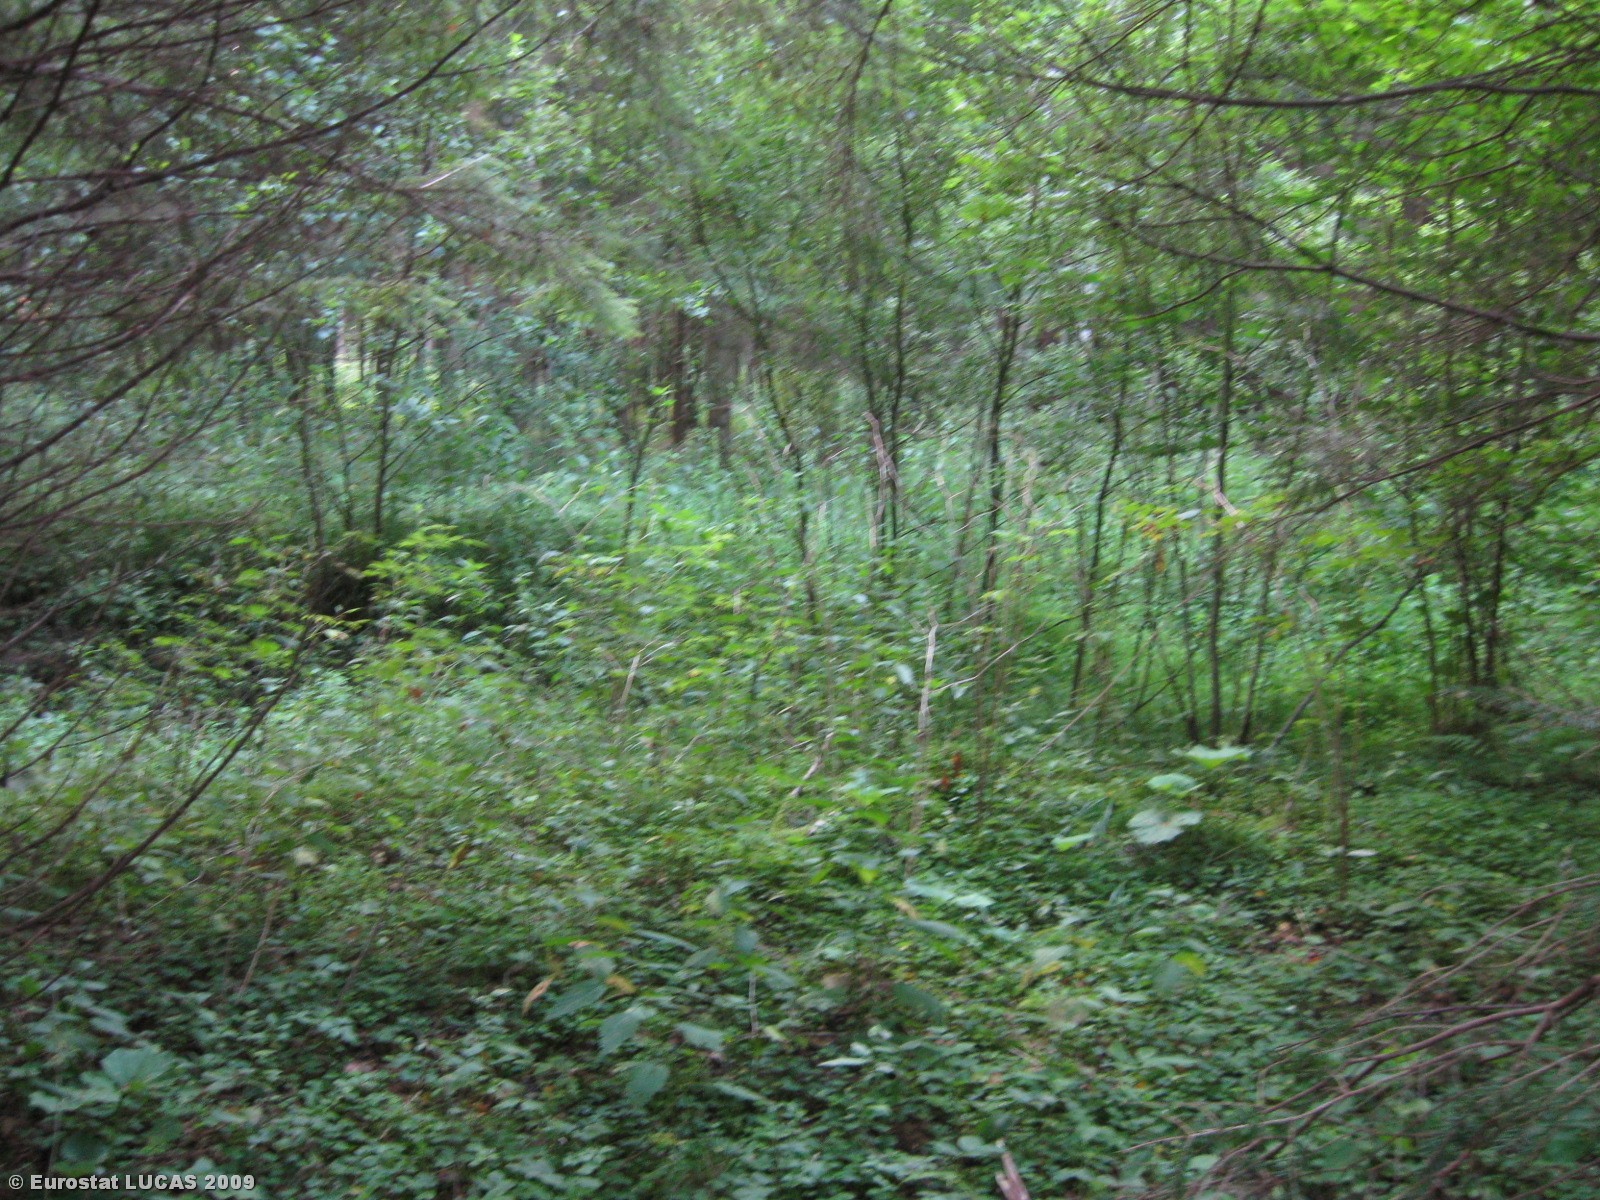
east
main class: Woodland
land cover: Mixed woodland
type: hemiboreal forest and nemoral coniferous forest and mixed broadleaved-coniferous forest
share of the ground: > 75 %
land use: Forestry
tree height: > 5 m
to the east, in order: Mixed woodland; Rivers and streams; Grass margins; Tracks; Mixed woodland; Tracks; Broadleaved woodland; Ditches and canals; Broadleaved woodland
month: August
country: LT
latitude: 55.2504
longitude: 22.6333
